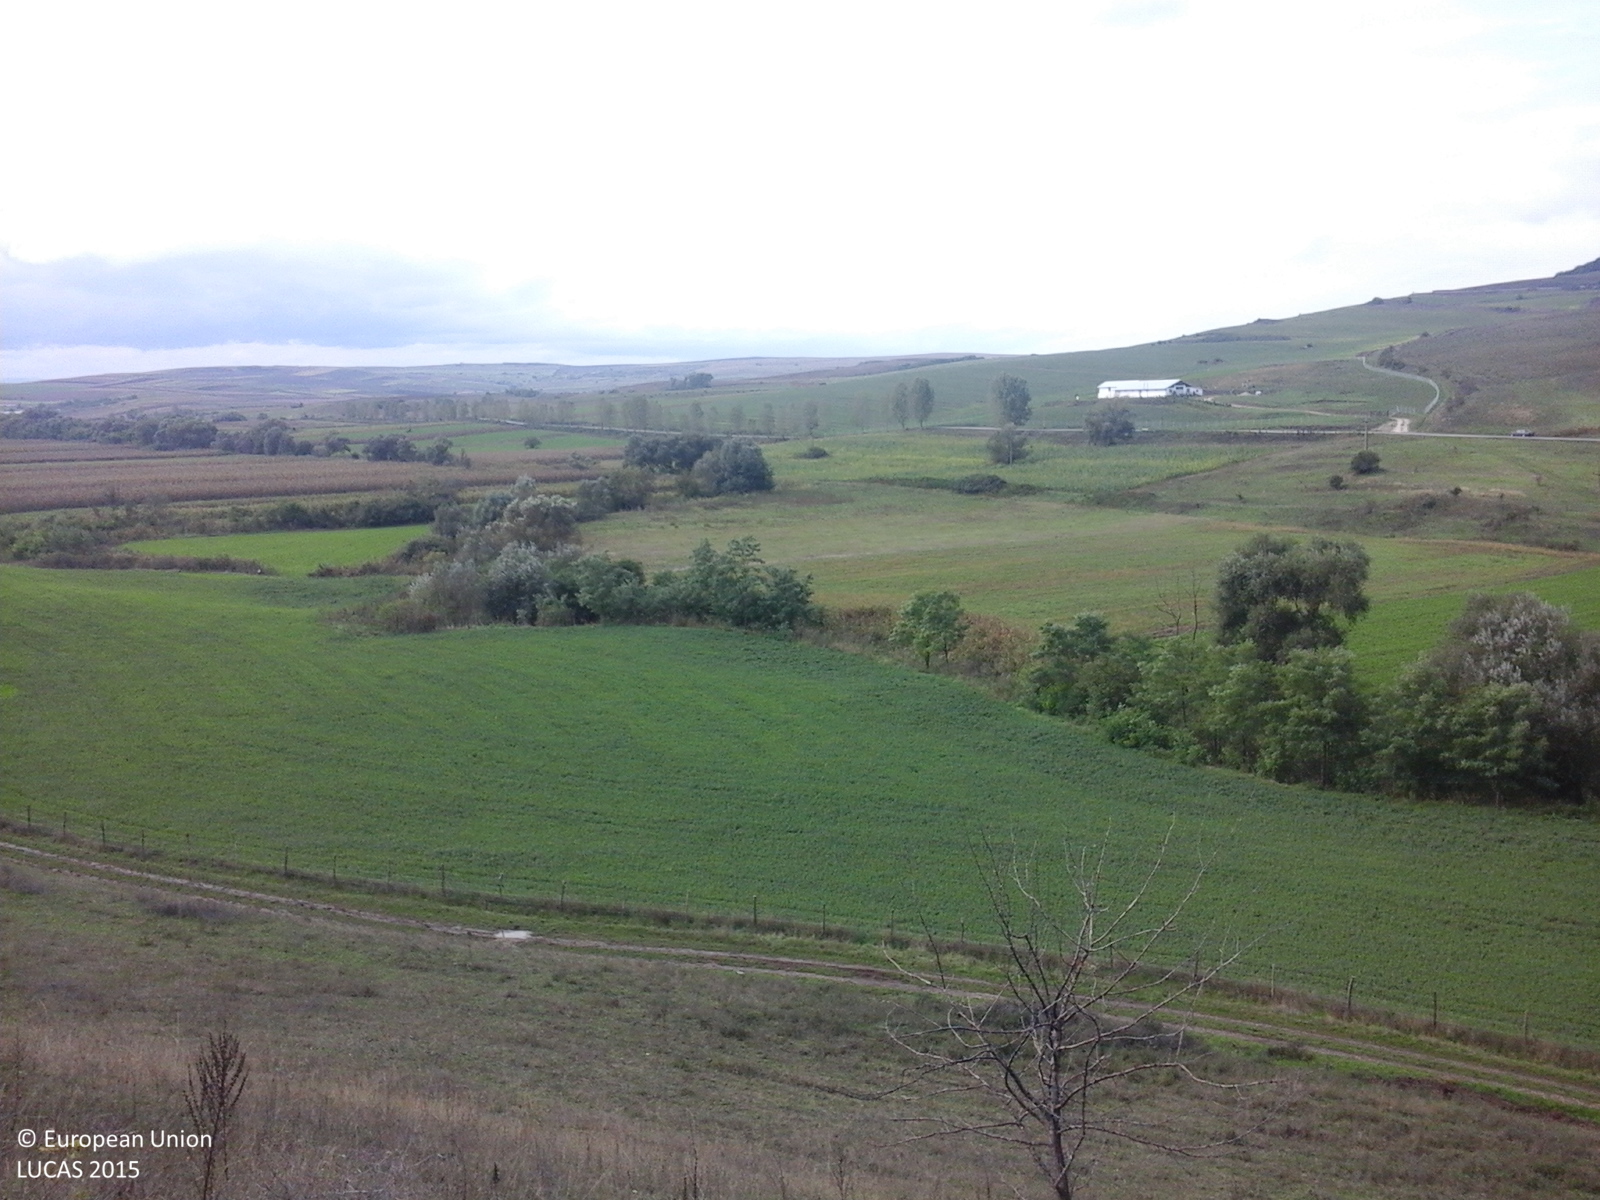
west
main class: Grassland
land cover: Grassland without tree/shrub cover
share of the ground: > 75 %
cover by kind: herbaceous plants 100 %
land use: Agriculture (excluding fallow land and kitchen gardens)
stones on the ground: < 10 %
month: September
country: RO
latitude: 46.0629
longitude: 23.7329
